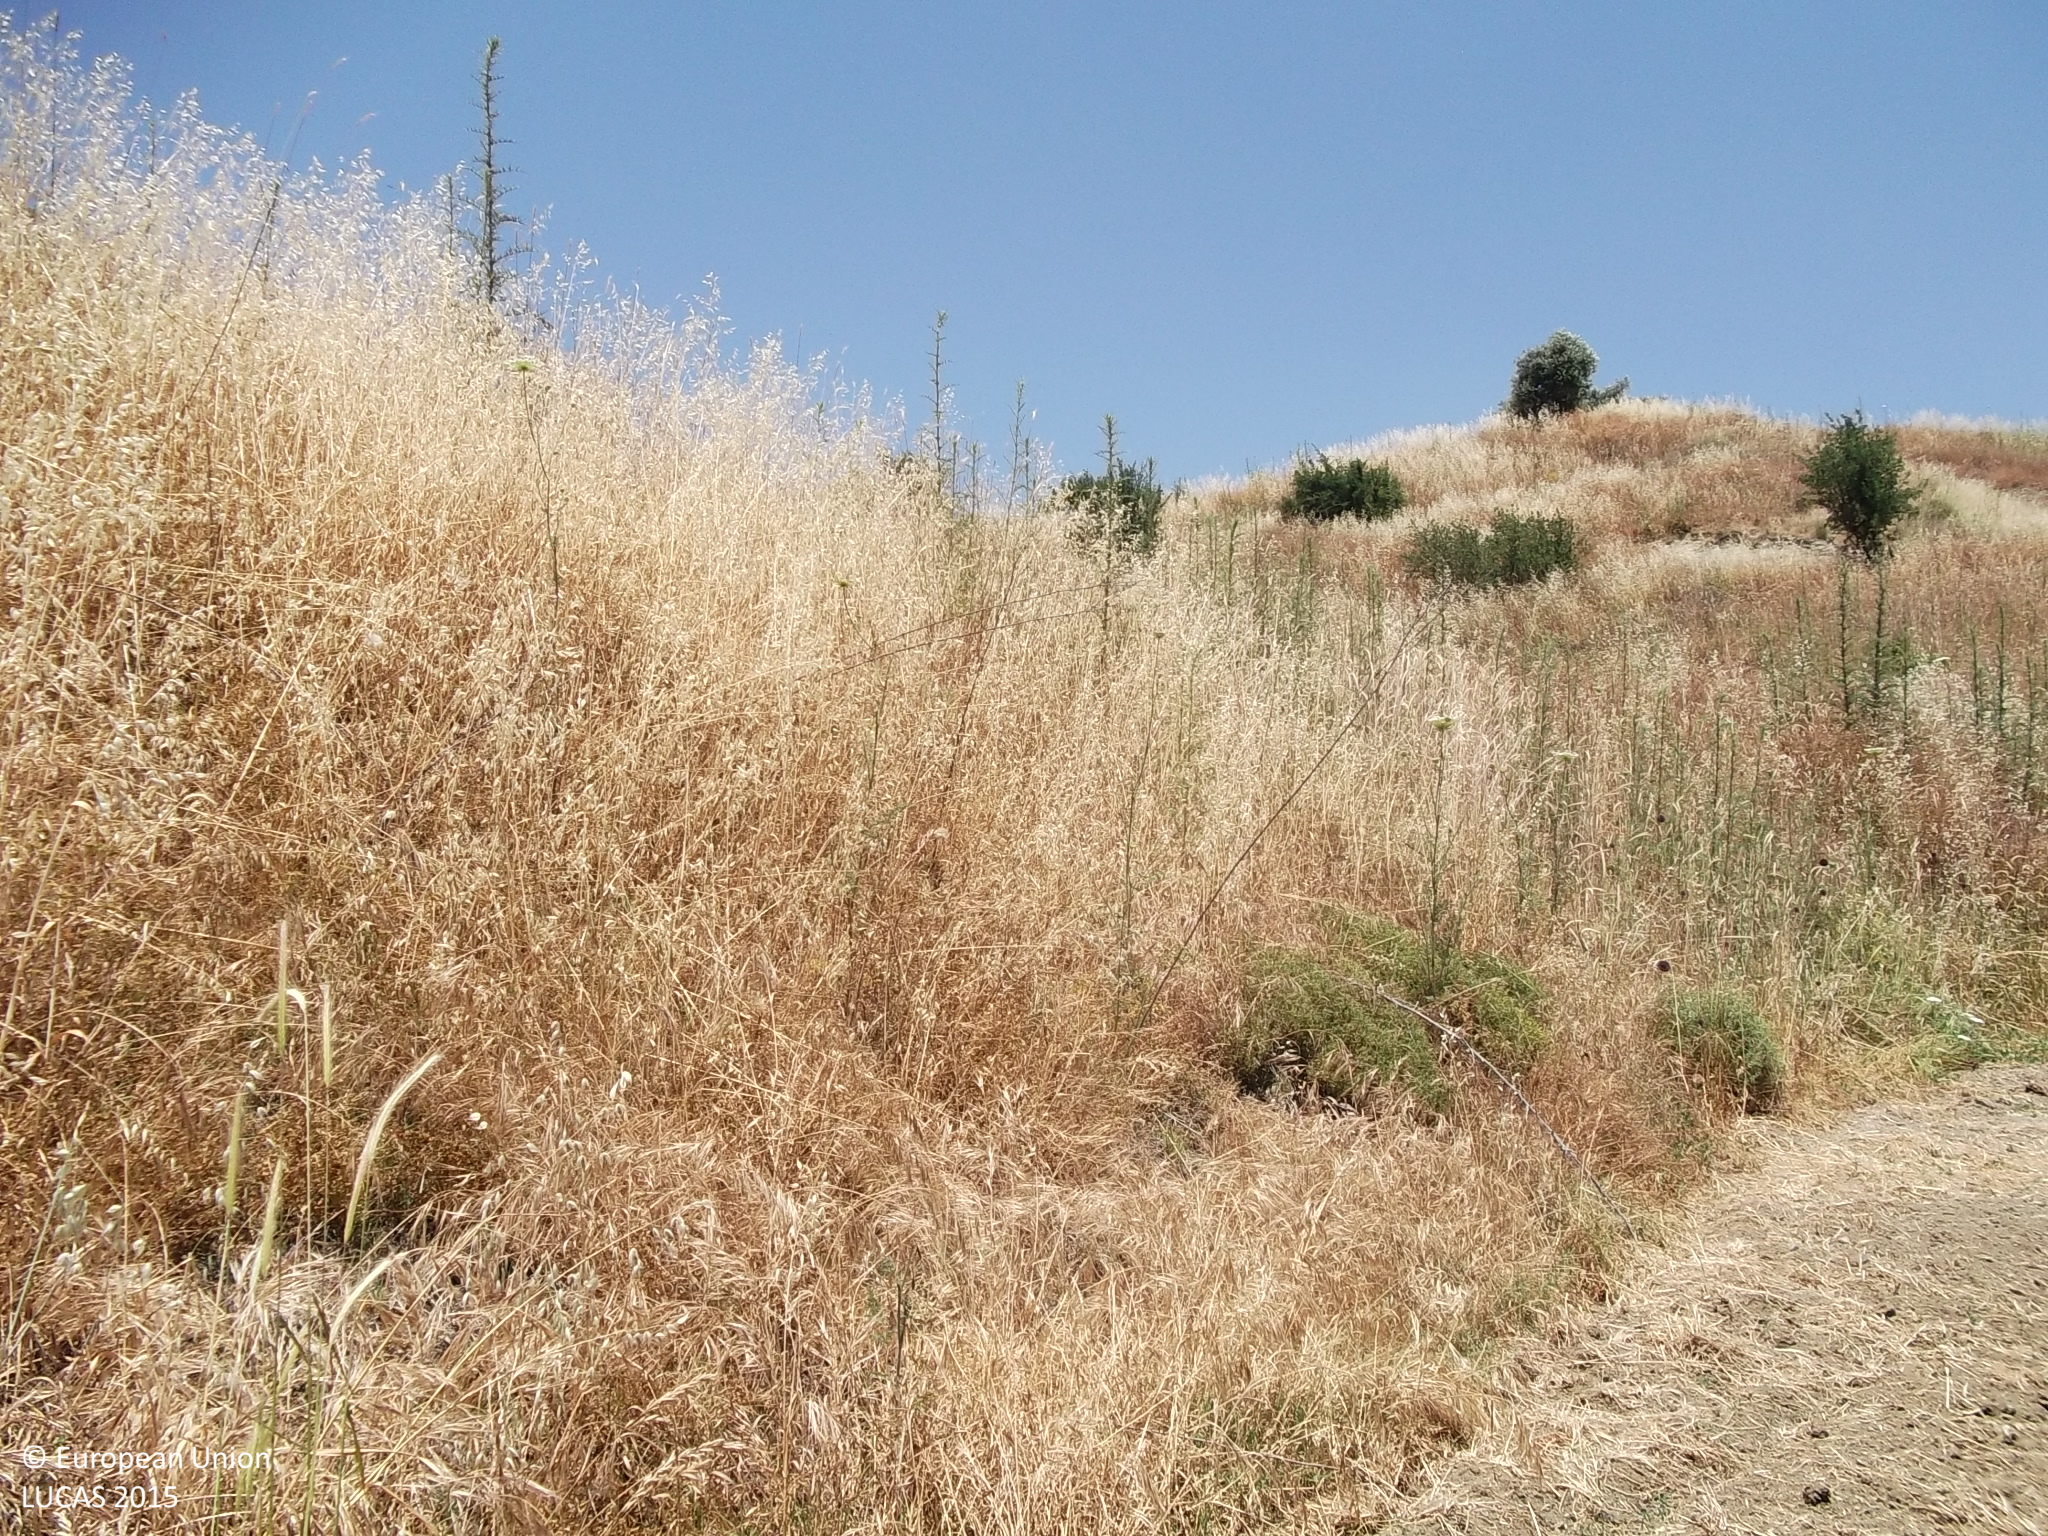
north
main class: Cropland
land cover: Other fruit trees and berries
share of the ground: 25 - 50 %
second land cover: Other bare soil
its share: > 75 %
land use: Agriculture (excluding fallow land and kitchen gardens)
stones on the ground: 10 - 25 %
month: May
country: CY
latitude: 34.9182
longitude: 32.5834
